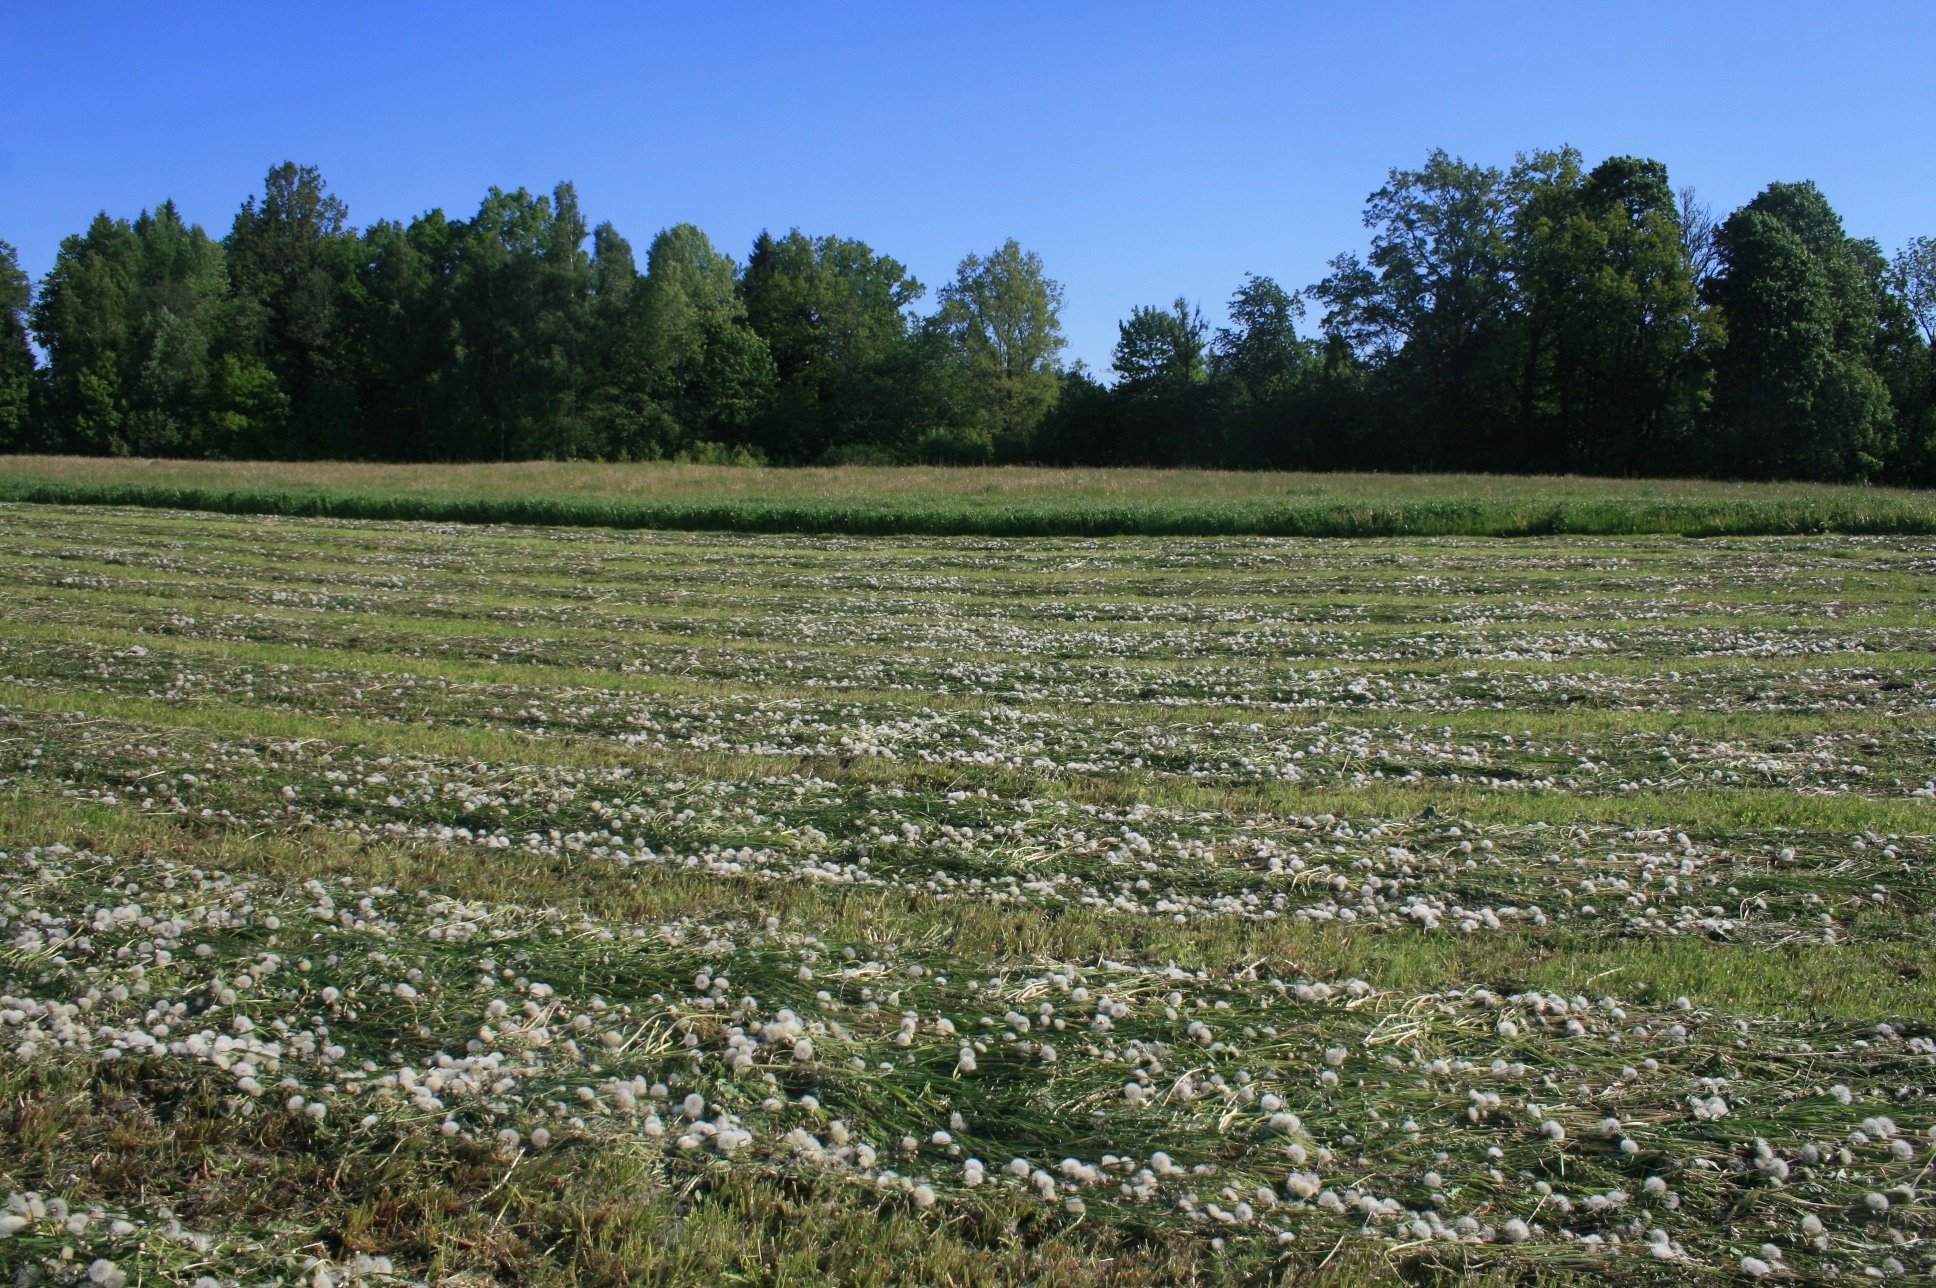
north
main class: Grassland
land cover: Grassland without tree/shrub cover
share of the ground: > 75 %
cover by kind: herbaceous plants 100 %
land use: Agriculture (excluding fallow land and kitchen gardens)
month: June
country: LT
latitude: 55.8777
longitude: 21.9919
